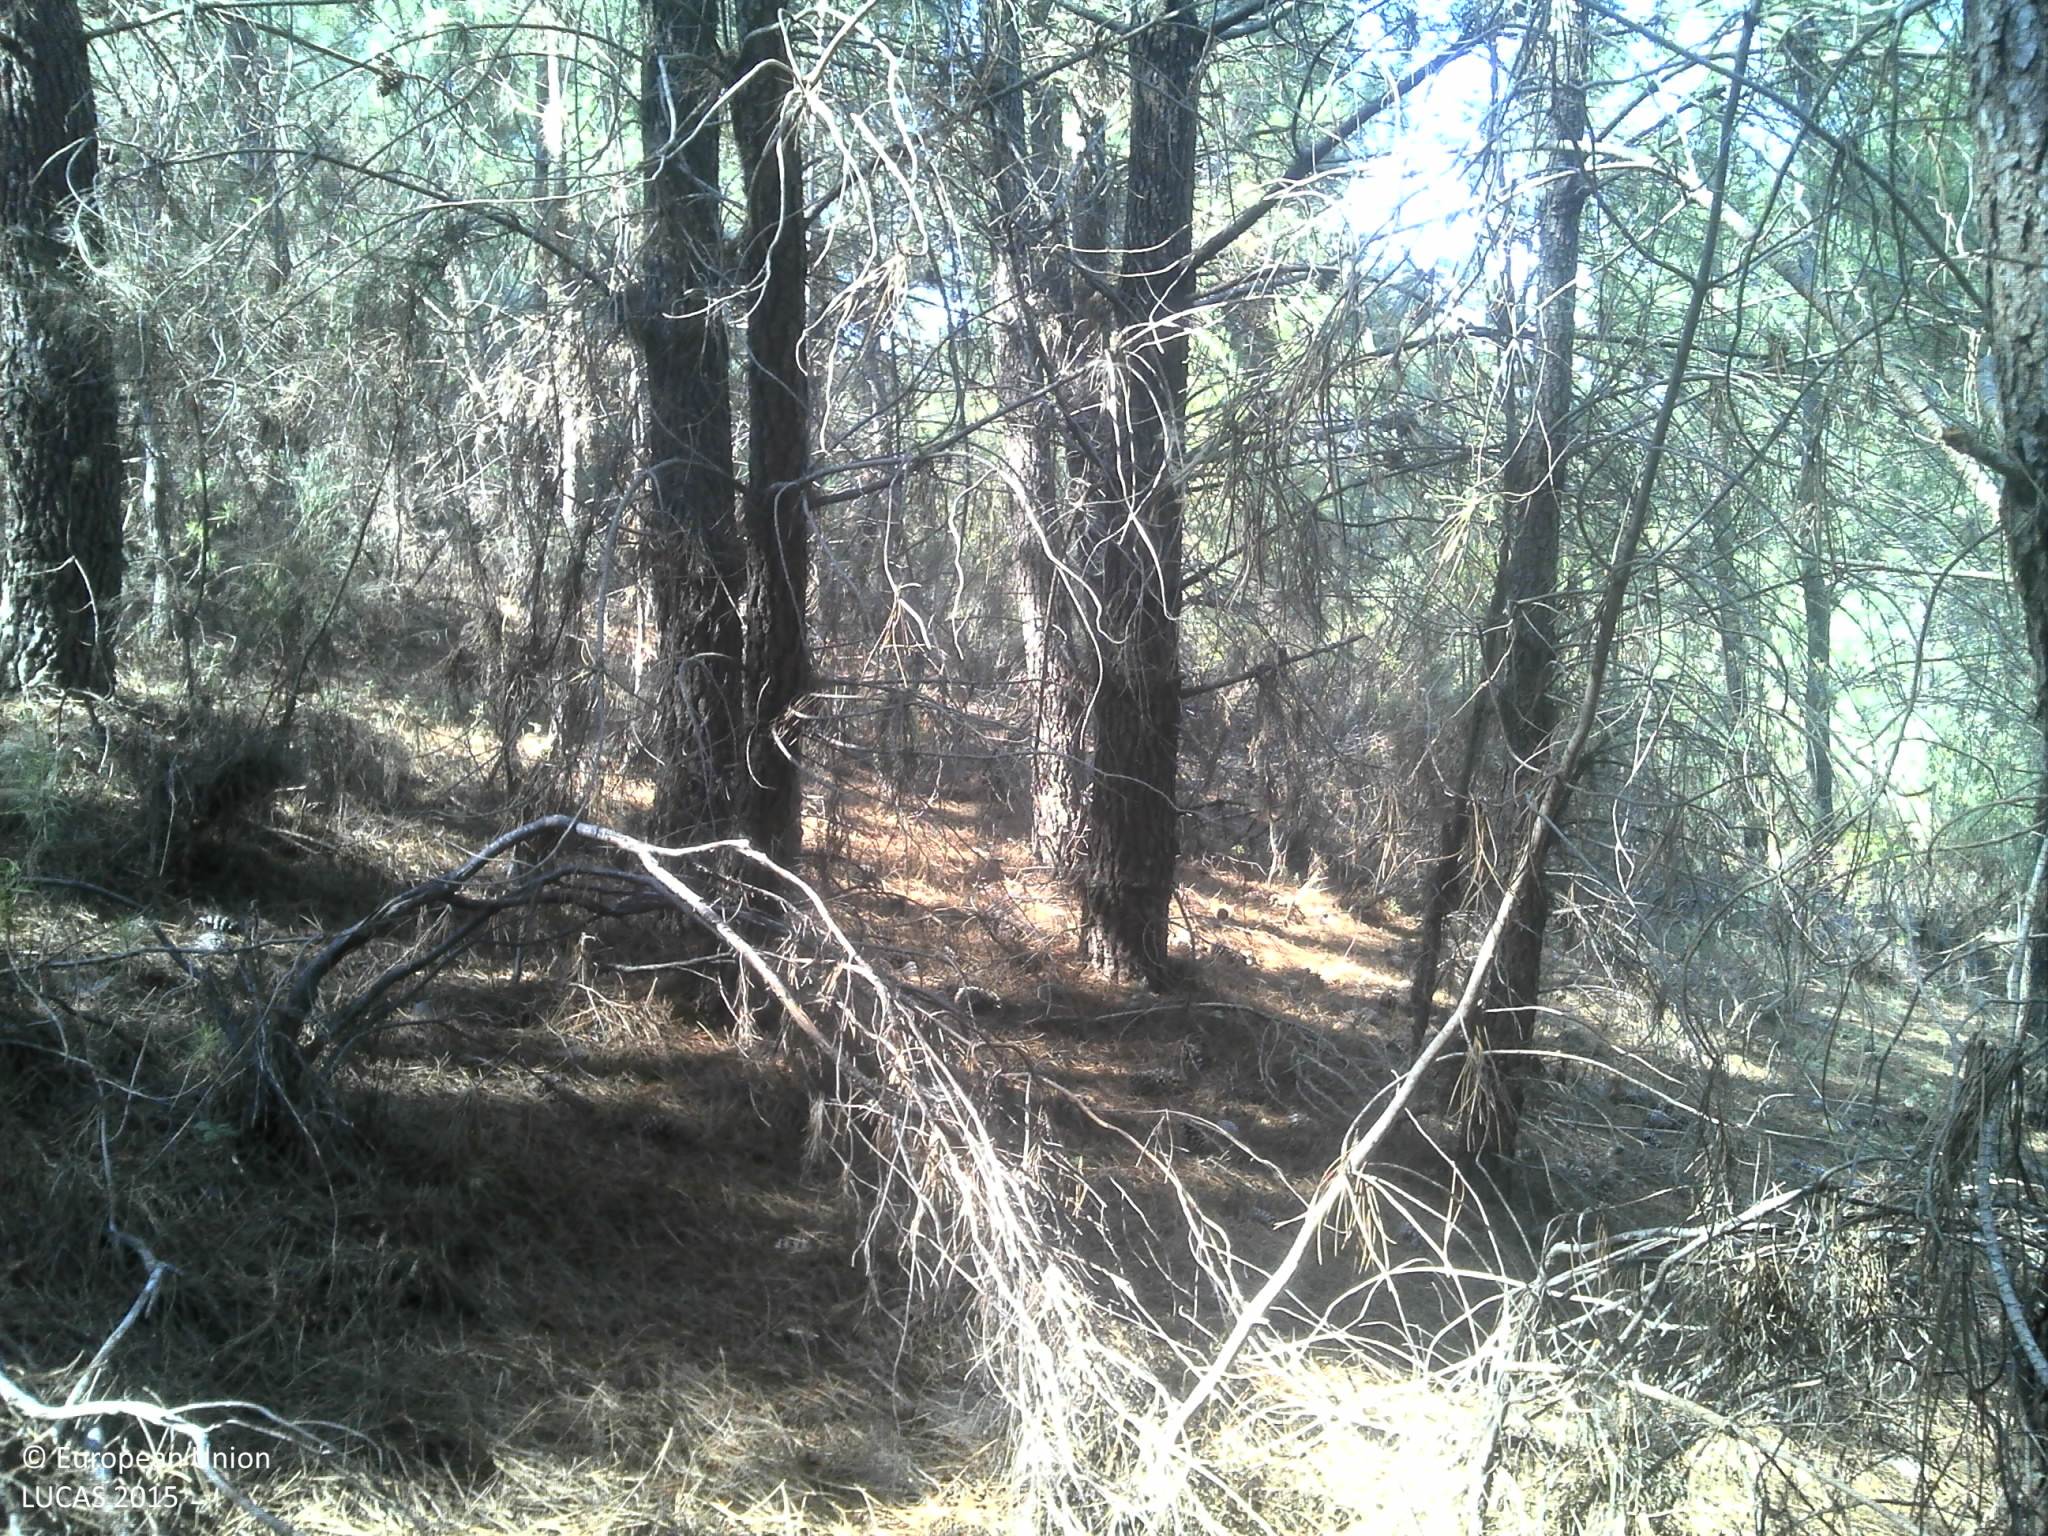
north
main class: Woodland
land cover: Pine dominated coniferous woodland
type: coniferous forest of the mediterranean region
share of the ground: > 75 %
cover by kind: coniferous forest trees 75 %, shrubs 15 %, unconsolidated bare surface 5 %
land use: Forestry
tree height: > 5 m
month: June
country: PT
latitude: 40.2987
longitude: -7.1218
